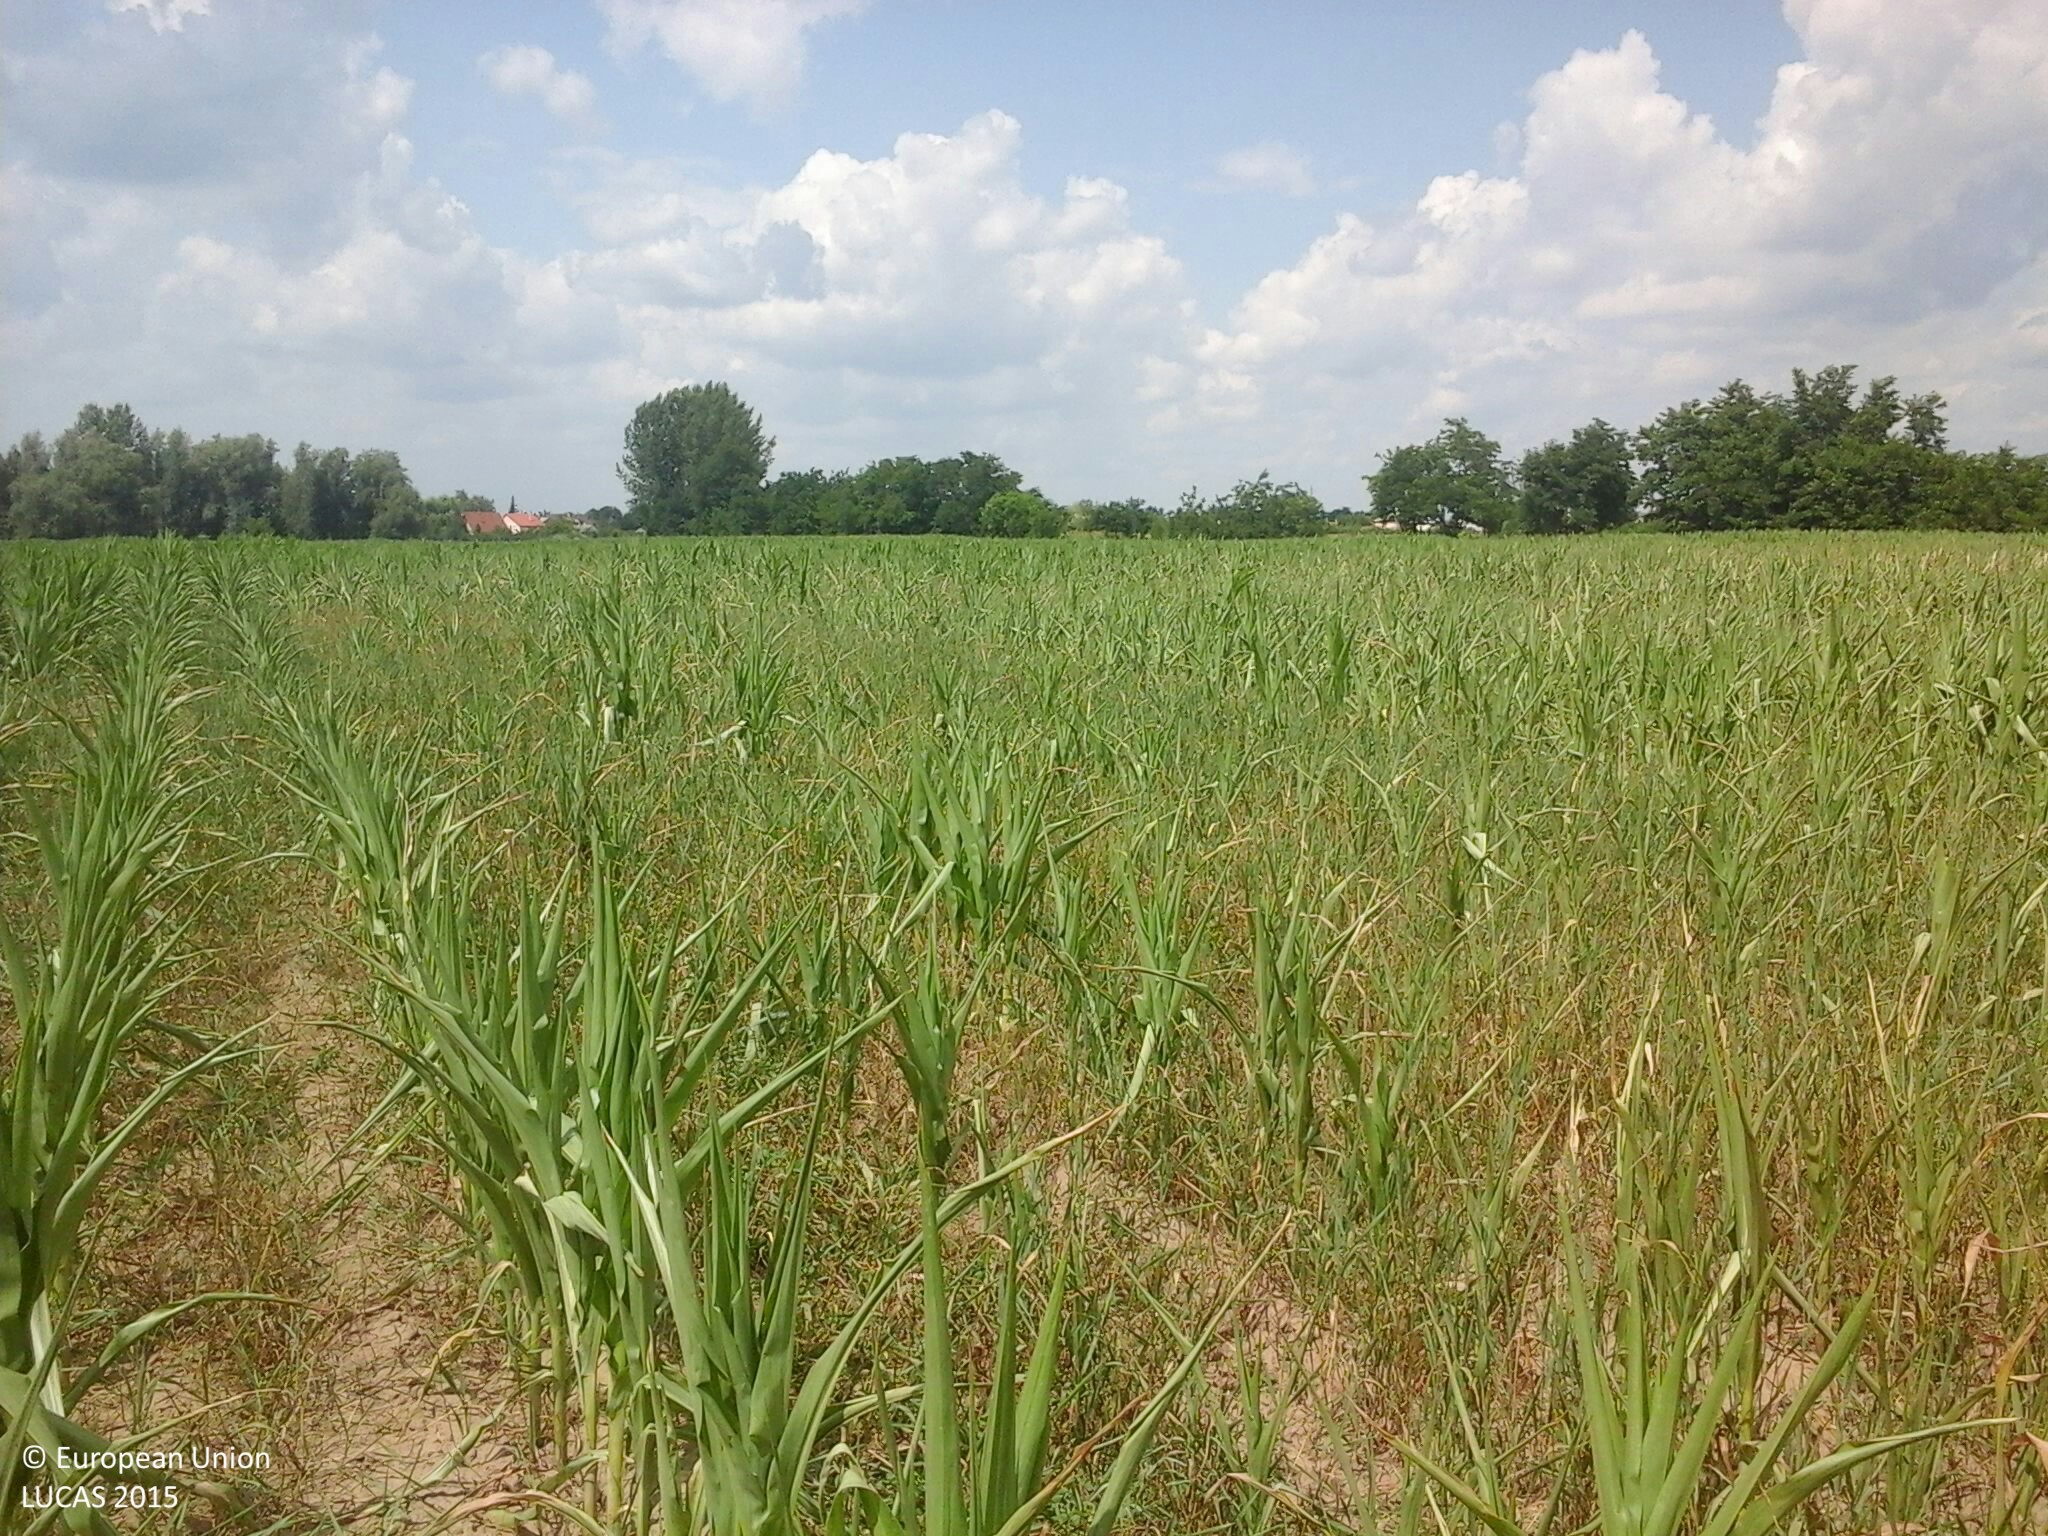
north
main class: Cropland
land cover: Maize
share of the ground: 25 - 50 %
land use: Agriculture (excluding fallow land and kitchen gardens)
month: July
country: HU
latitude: 47.8225
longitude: 22.1413
